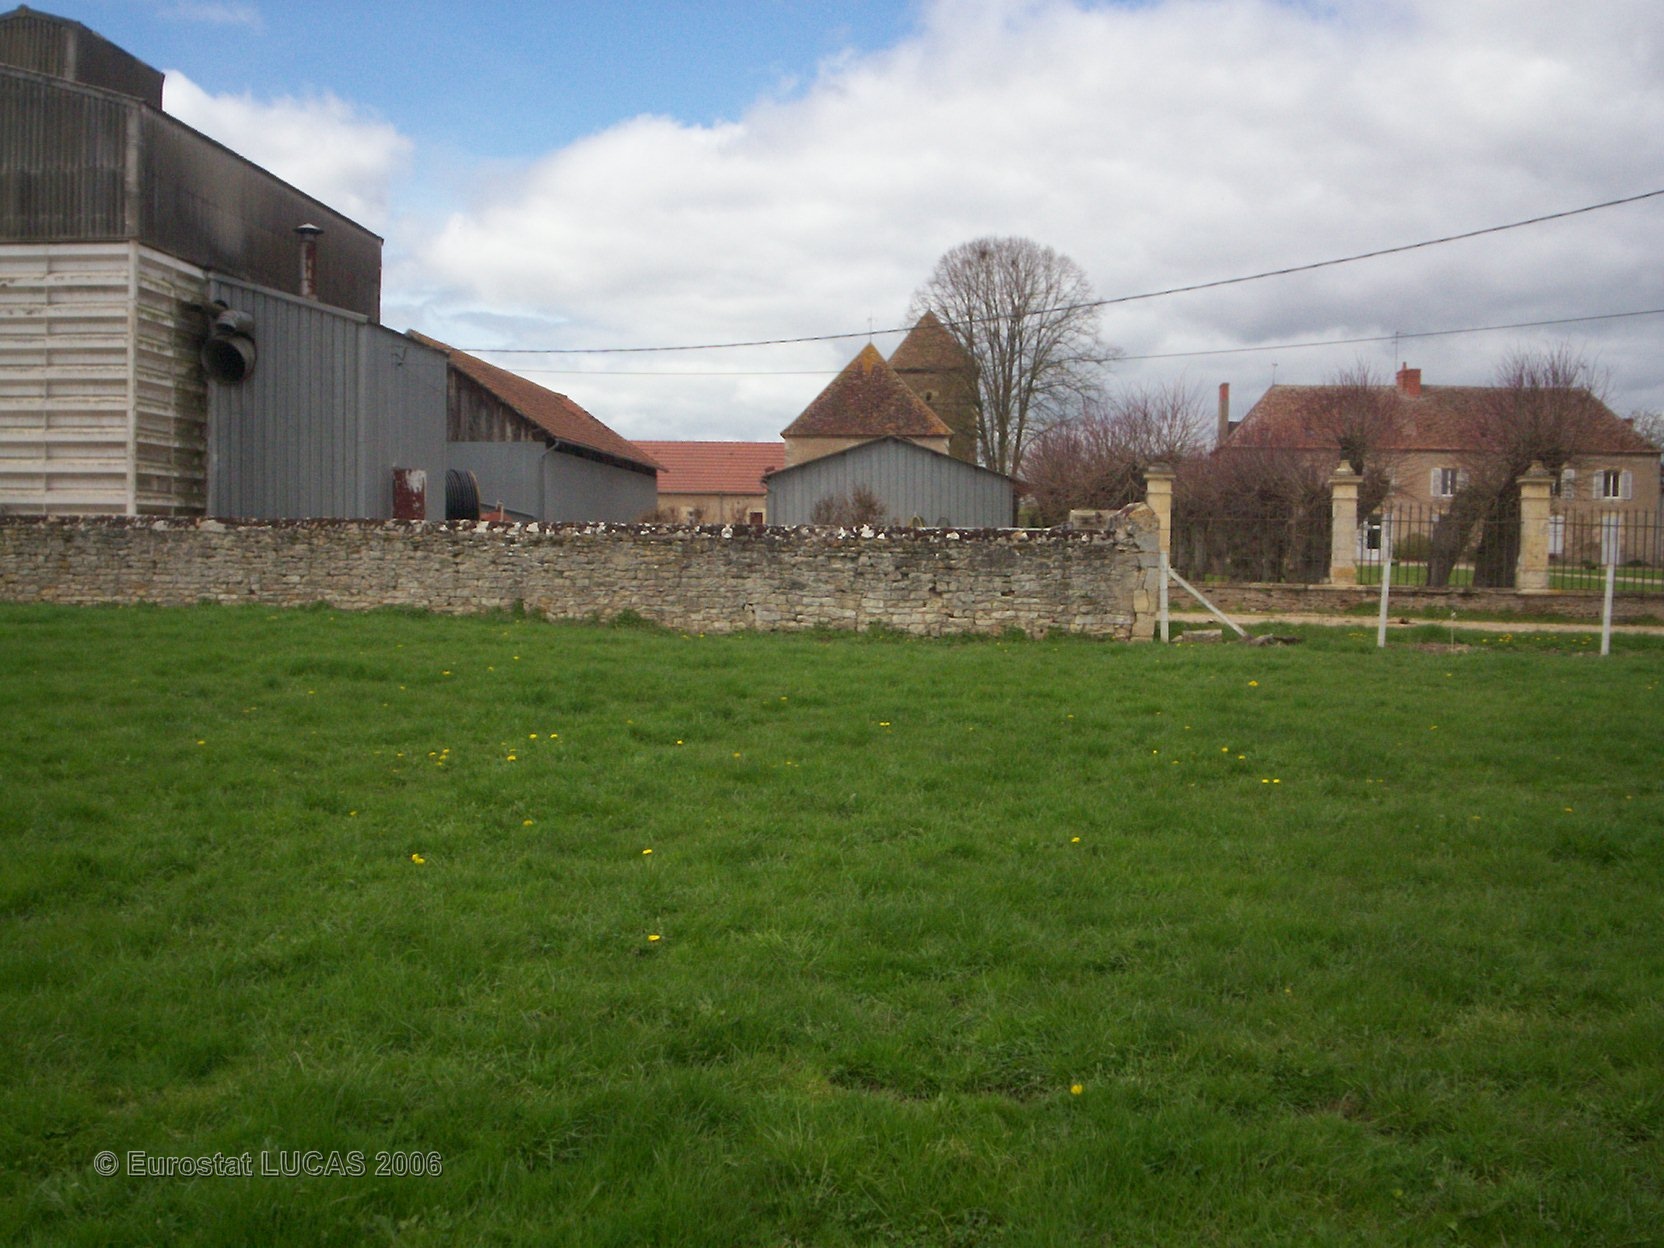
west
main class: Grassland
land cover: Grassland without tree/shrub cover
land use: Agriculture (excluding fallow land and kitchen gardens)
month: April
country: FR
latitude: 46.7931
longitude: 3.0399
